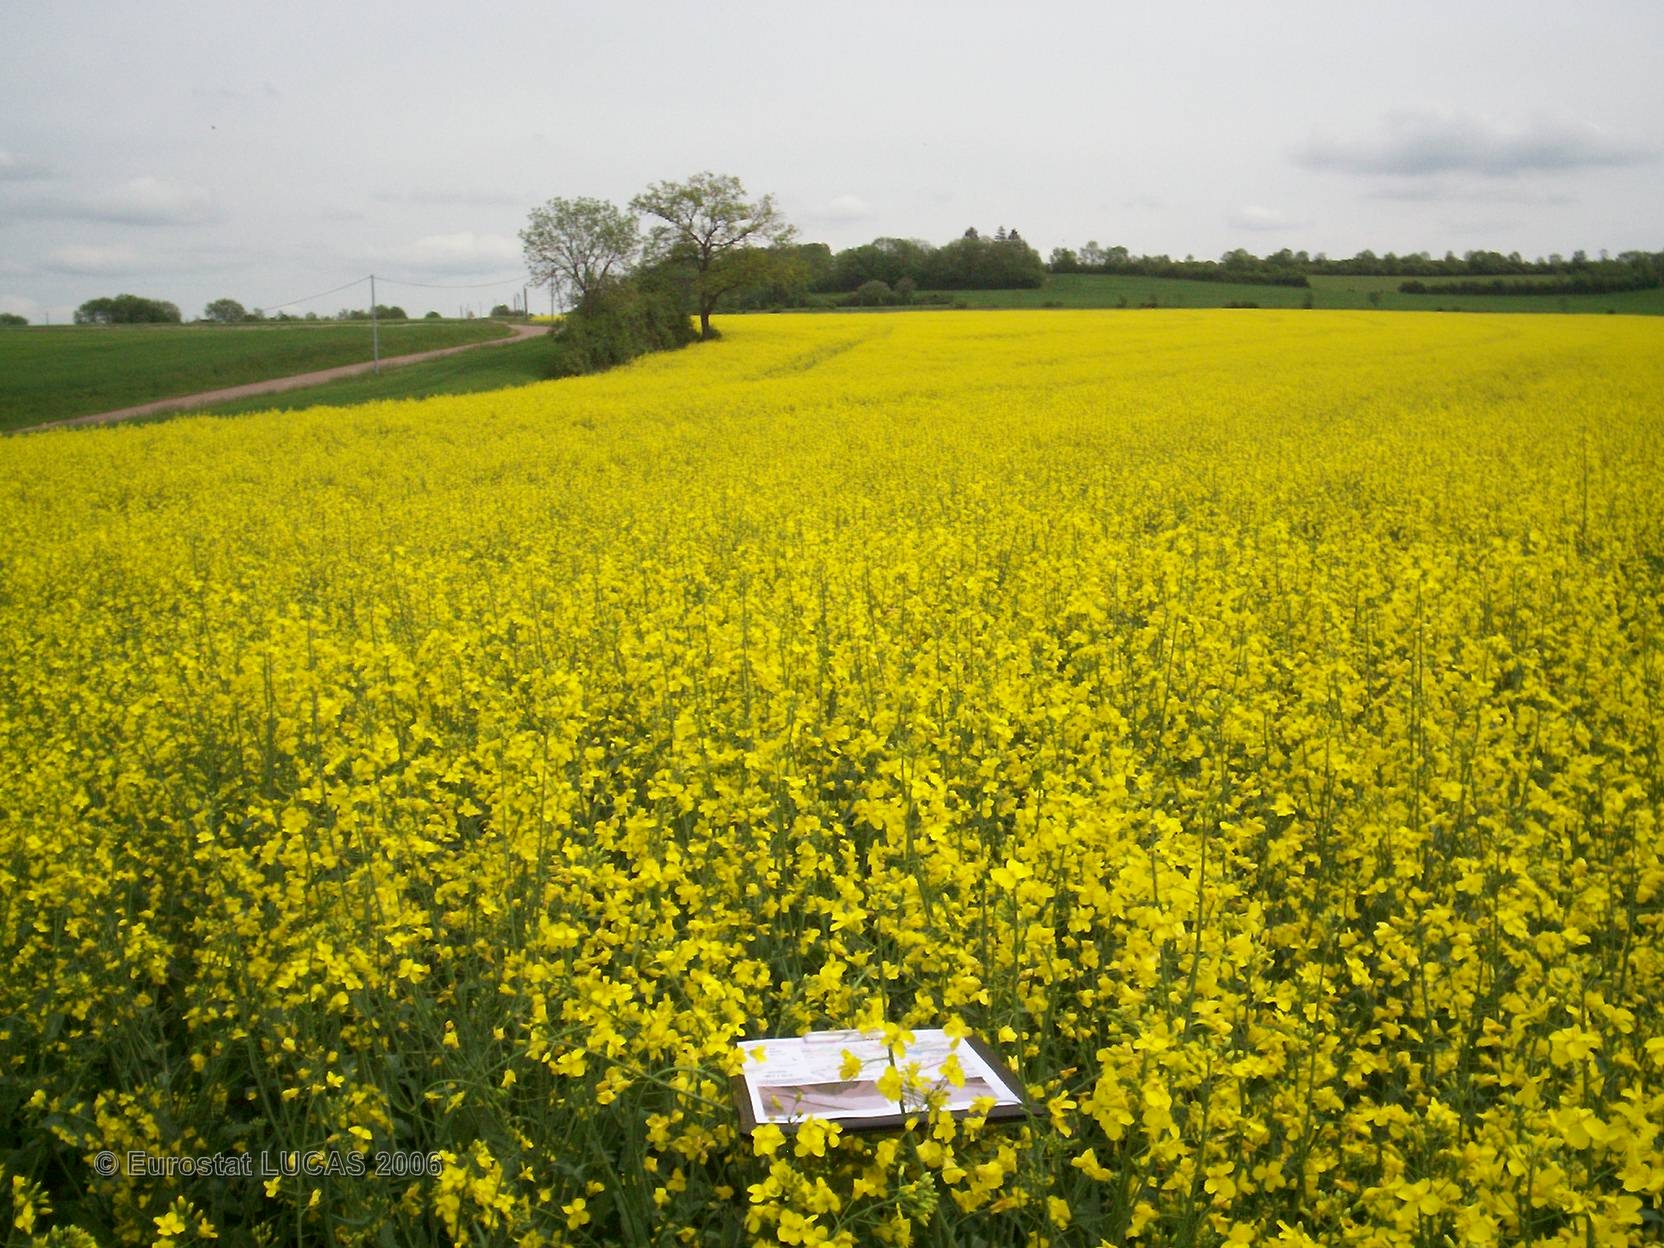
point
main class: Cropland
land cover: Rape and turnip rape
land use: Agriculture (excluding fallow land and kitchen gardens)
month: May
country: FR
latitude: 47.2971
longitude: 4.5909
